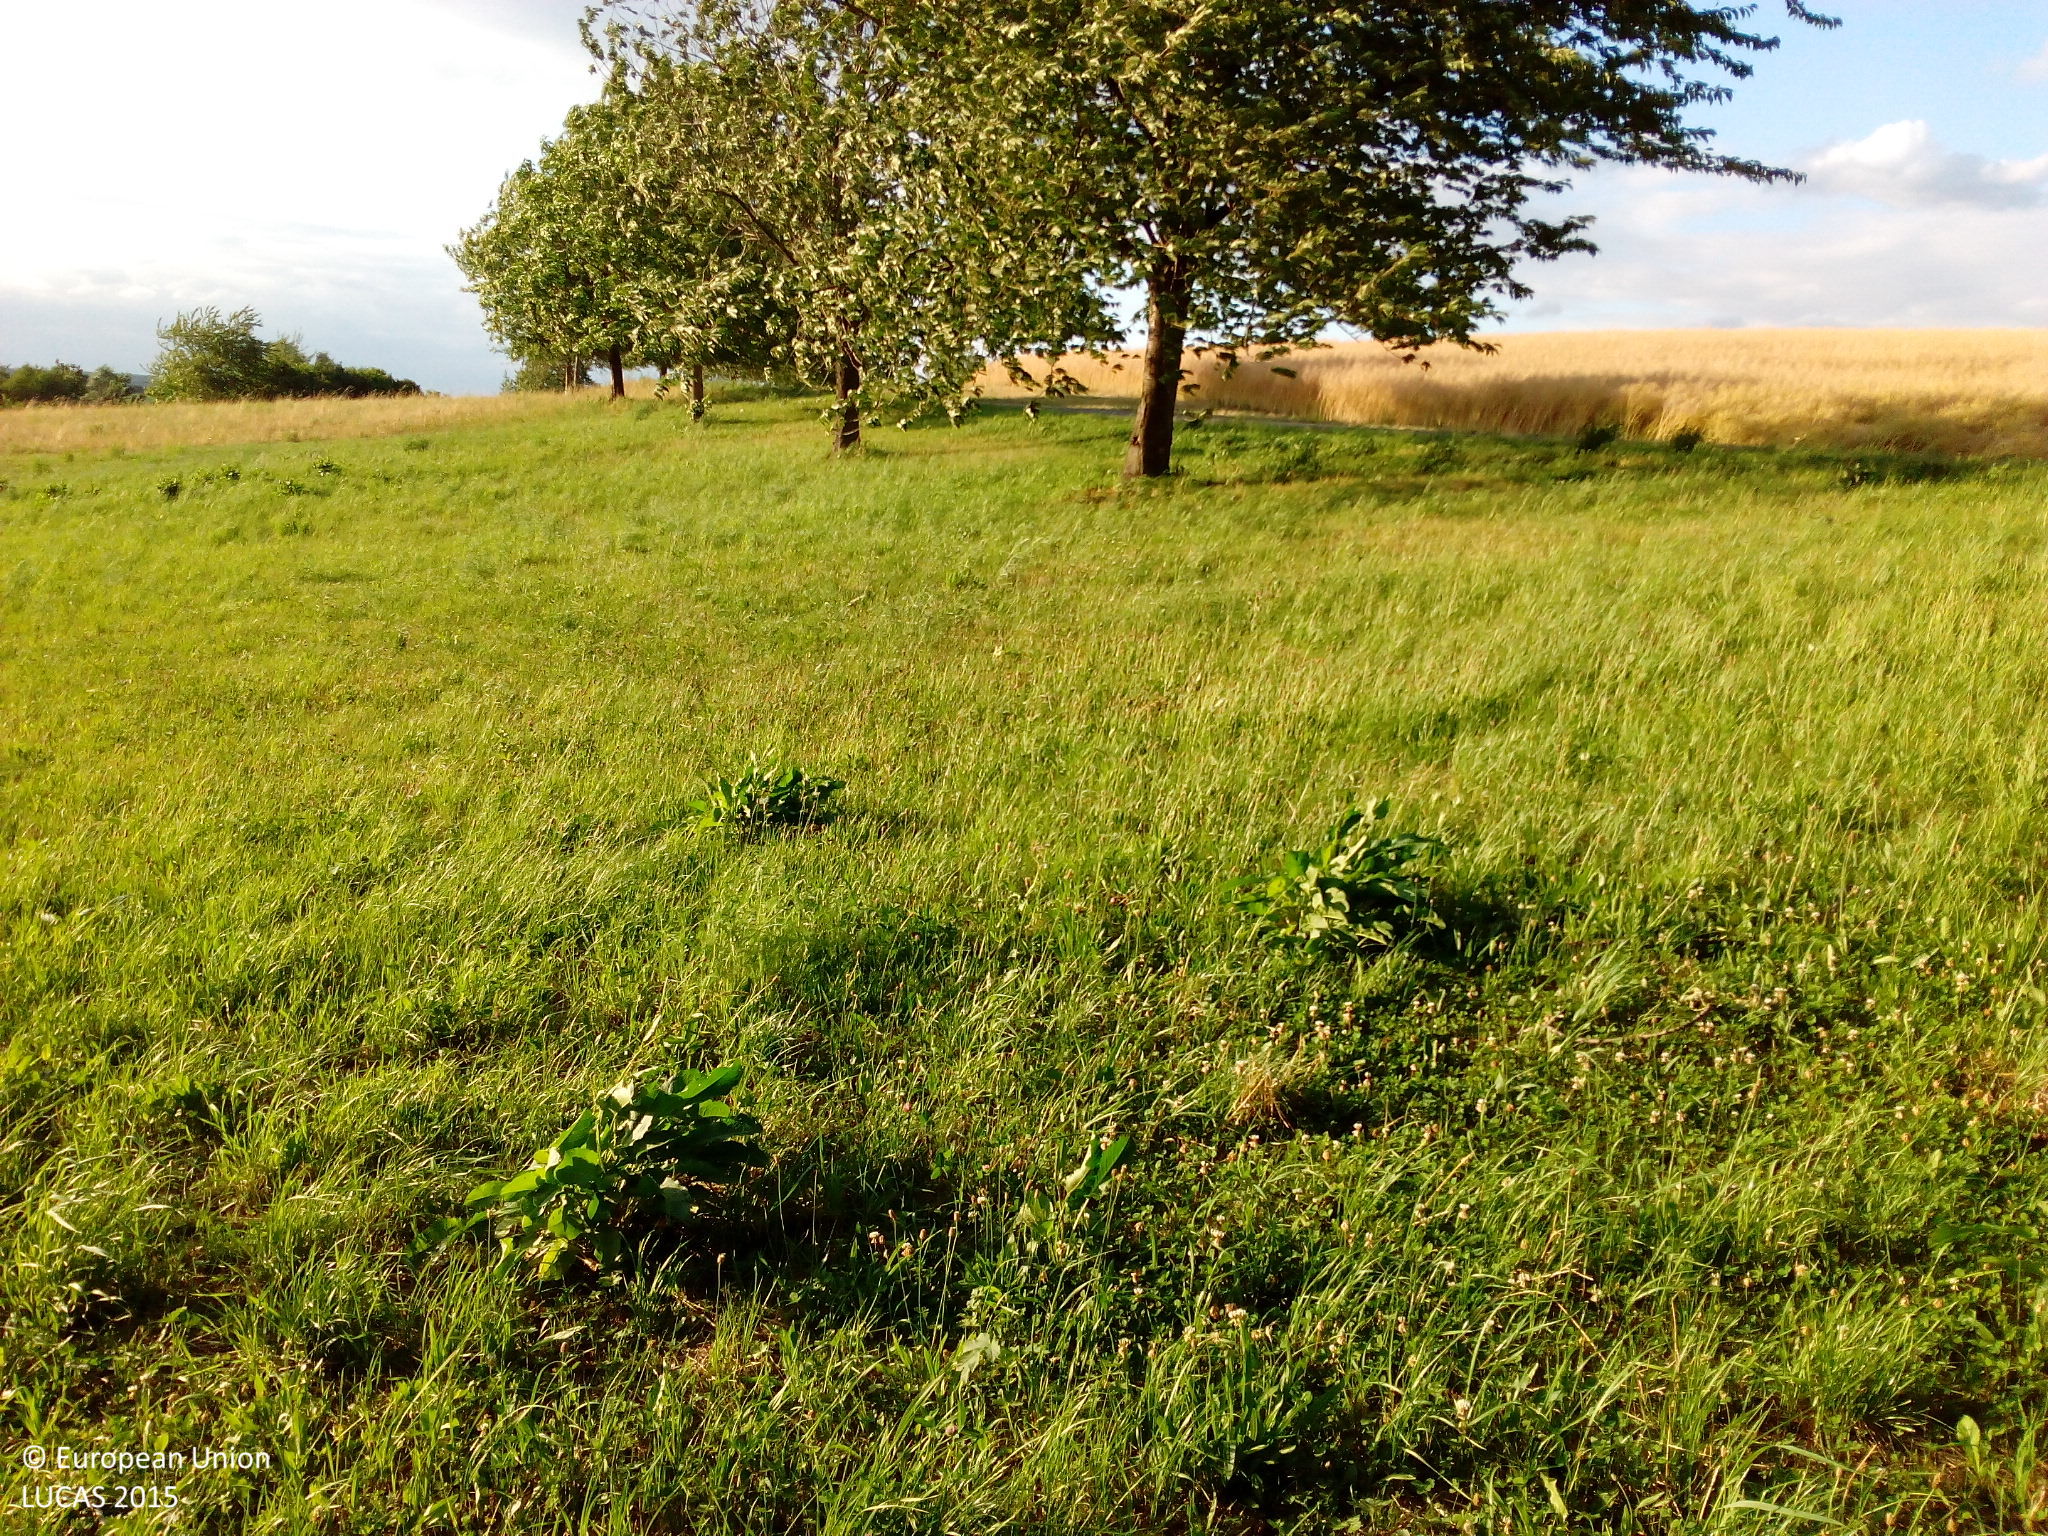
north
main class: Grassland
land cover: Grassland without tree/shrub cover
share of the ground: > 75 %
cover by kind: herbaceous plants 100 %
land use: Agriculture (excluding fallow land and kitchen gardens)
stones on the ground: < 10 %
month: July
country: DE
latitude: 49.6987
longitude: 9.9307
